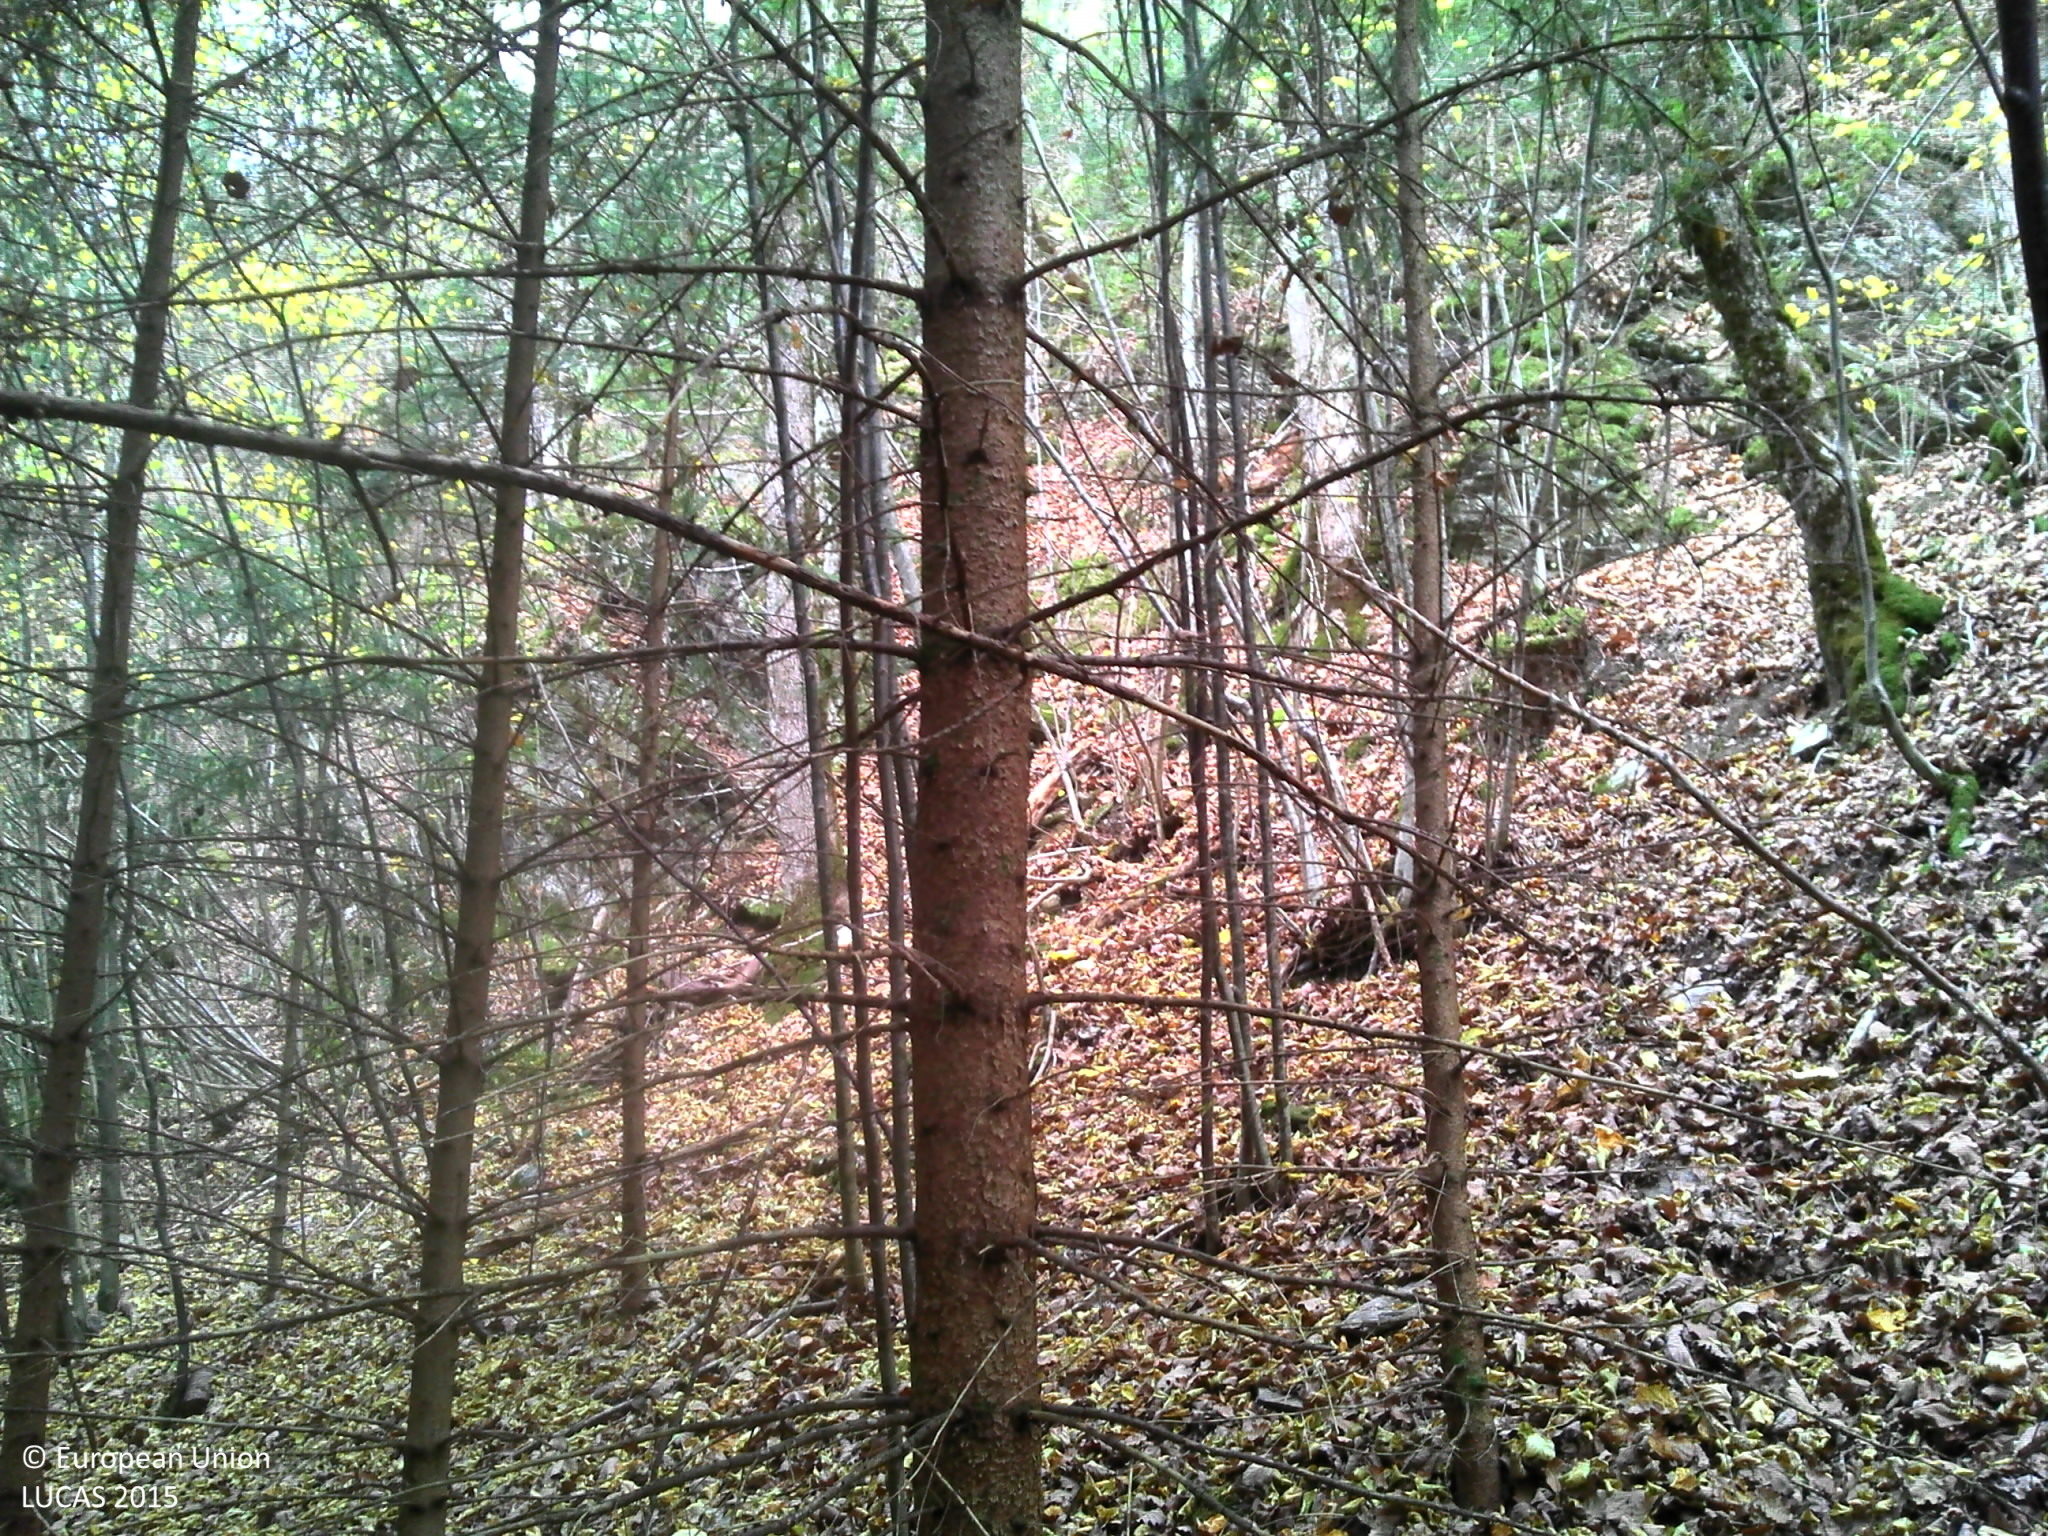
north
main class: Woodland
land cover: Spruce dominated mixed woodland
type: hemiboreal forest and nemoral coniferous forest and mixed broadleaved-coniferous forest
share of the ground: > 75 %
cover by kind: coniferous forest trees 50 %, broadleaved forest trees 40 %, consolidated bare surface 10 %
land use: Forestry
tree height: > 5 m
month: November
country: FR
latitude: 45.7160
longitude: 6.4713
